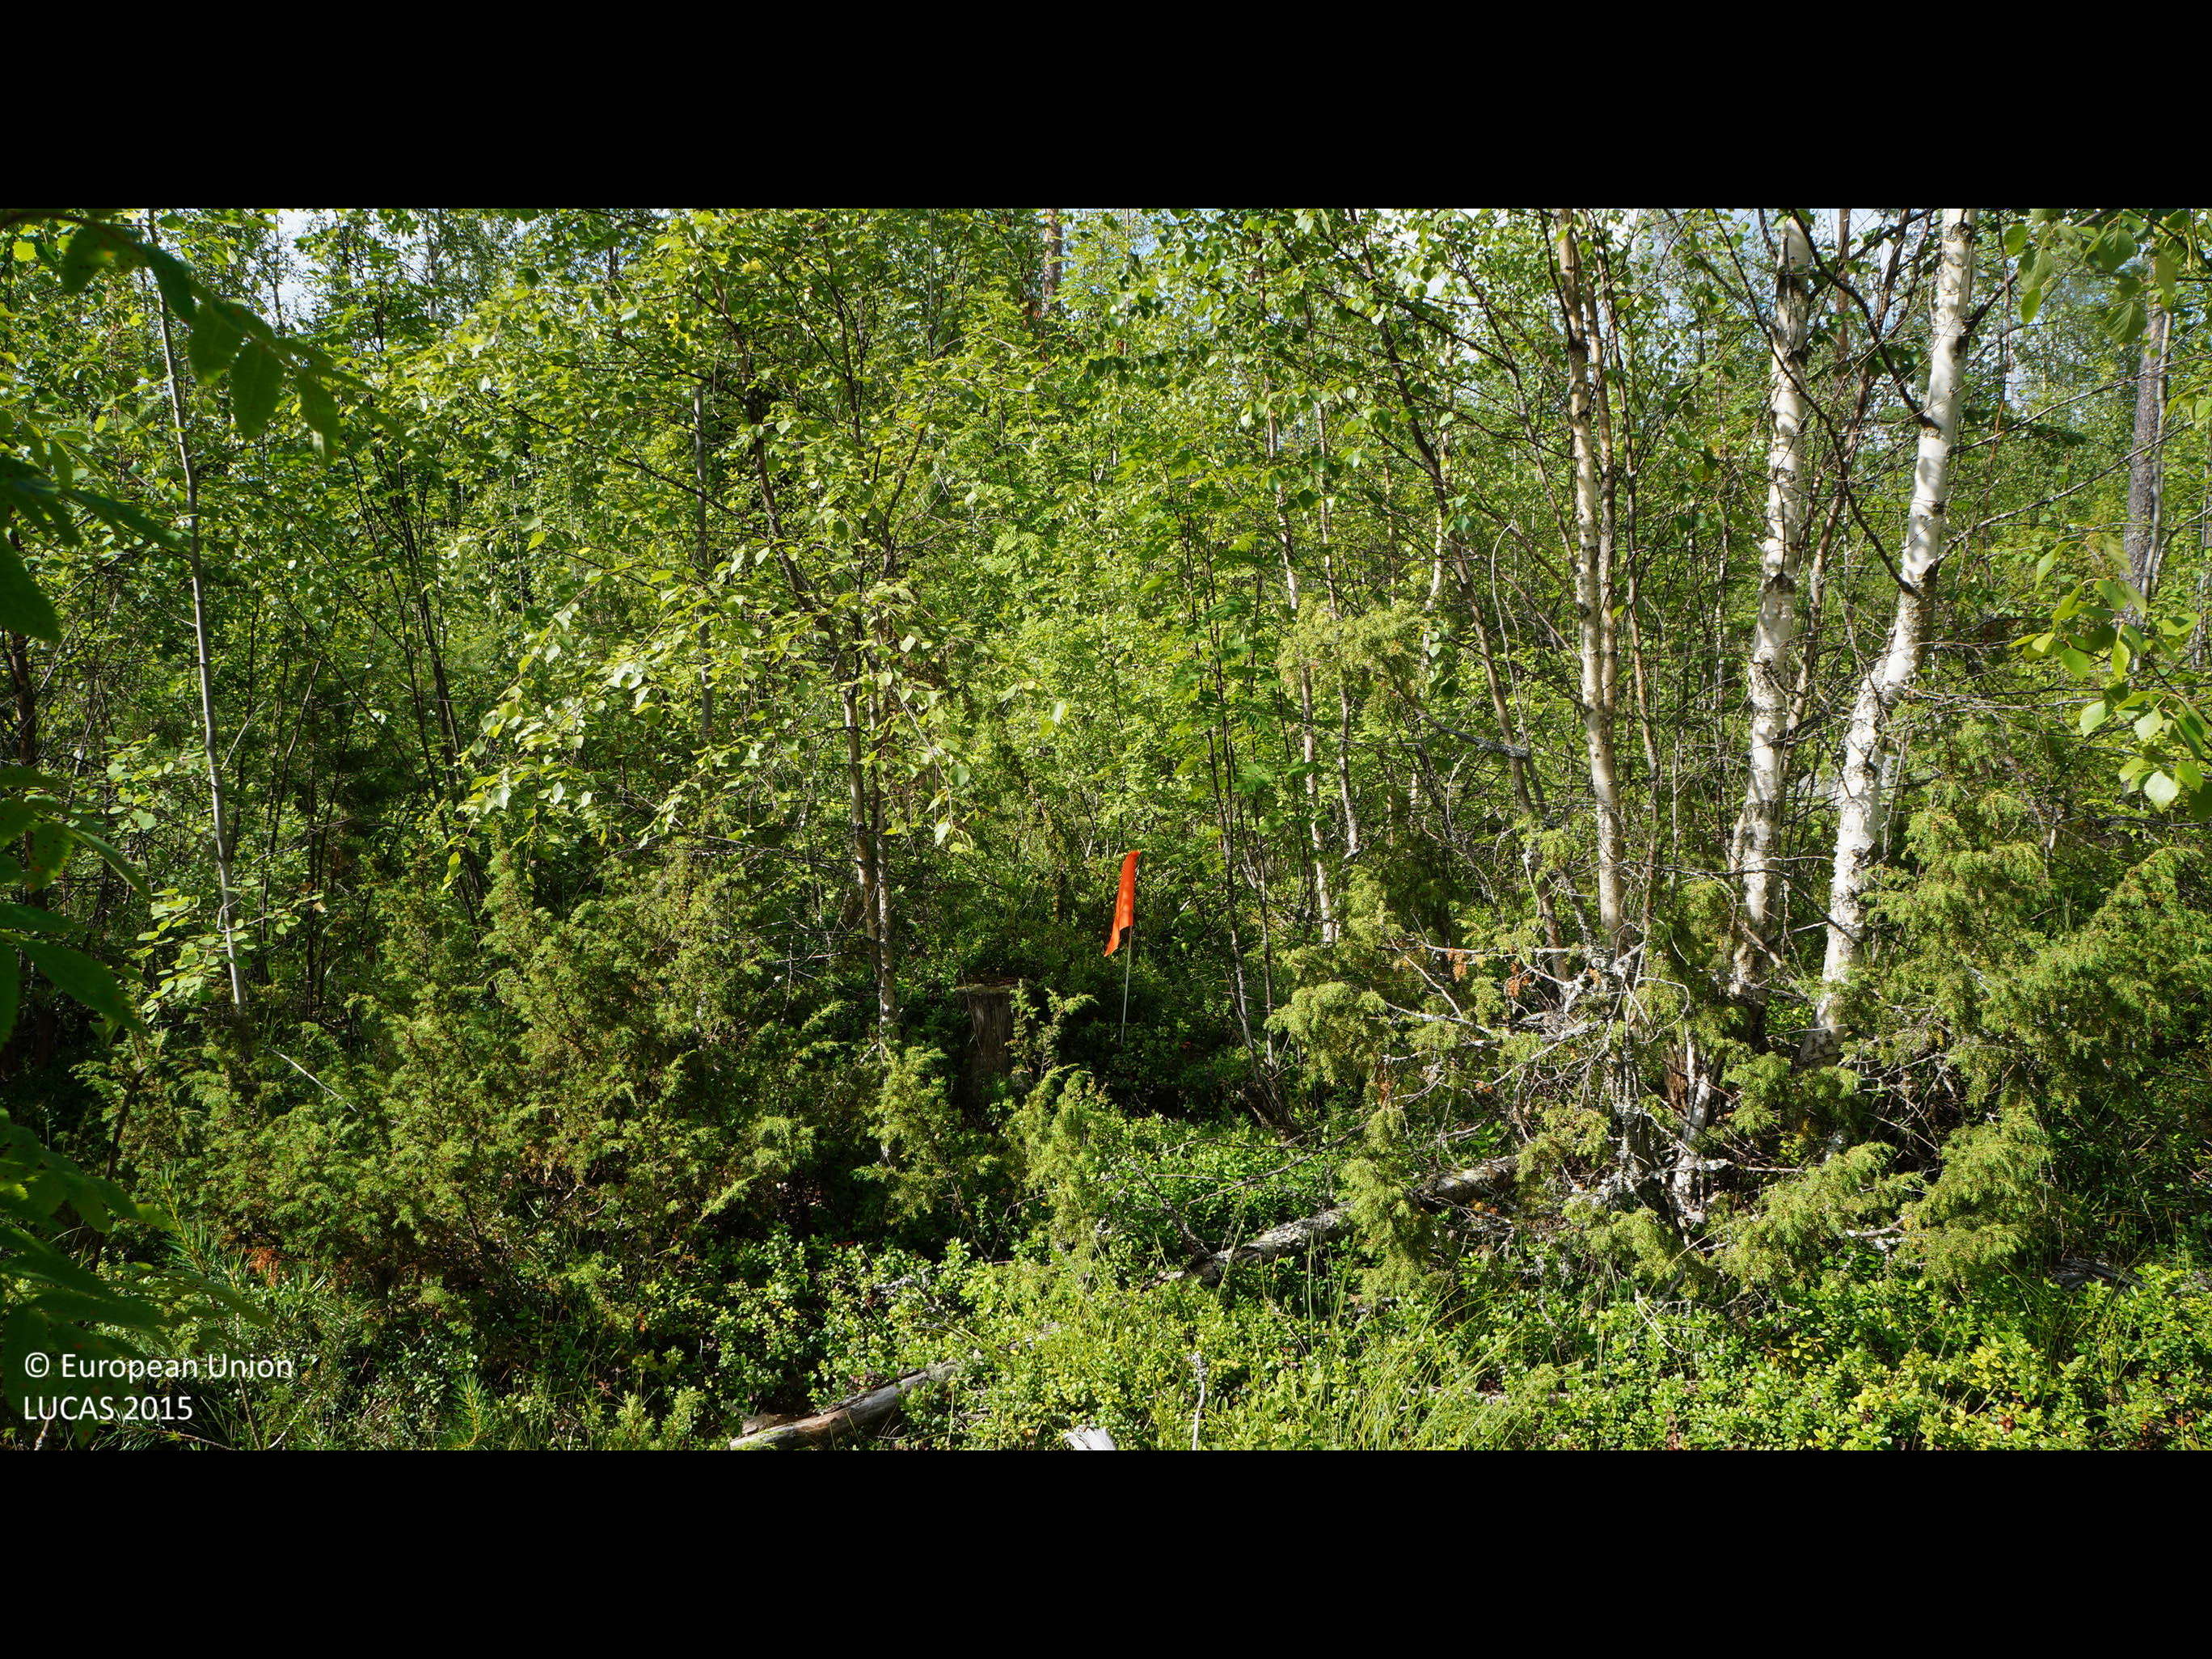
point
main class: Woodland
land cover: Pine dominated mixed woodland
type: boreal forest
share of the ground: 50 - 75 %
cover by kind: shrubs 40 %, coniferous forest trees 25 %, broadleaved forest trees 25 %, herbaceous plants 5 %, lichens and mosses 5 %
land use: Forestry
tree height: > 5 m
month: July
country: FI
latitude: 64.0018
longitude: 24.3229
